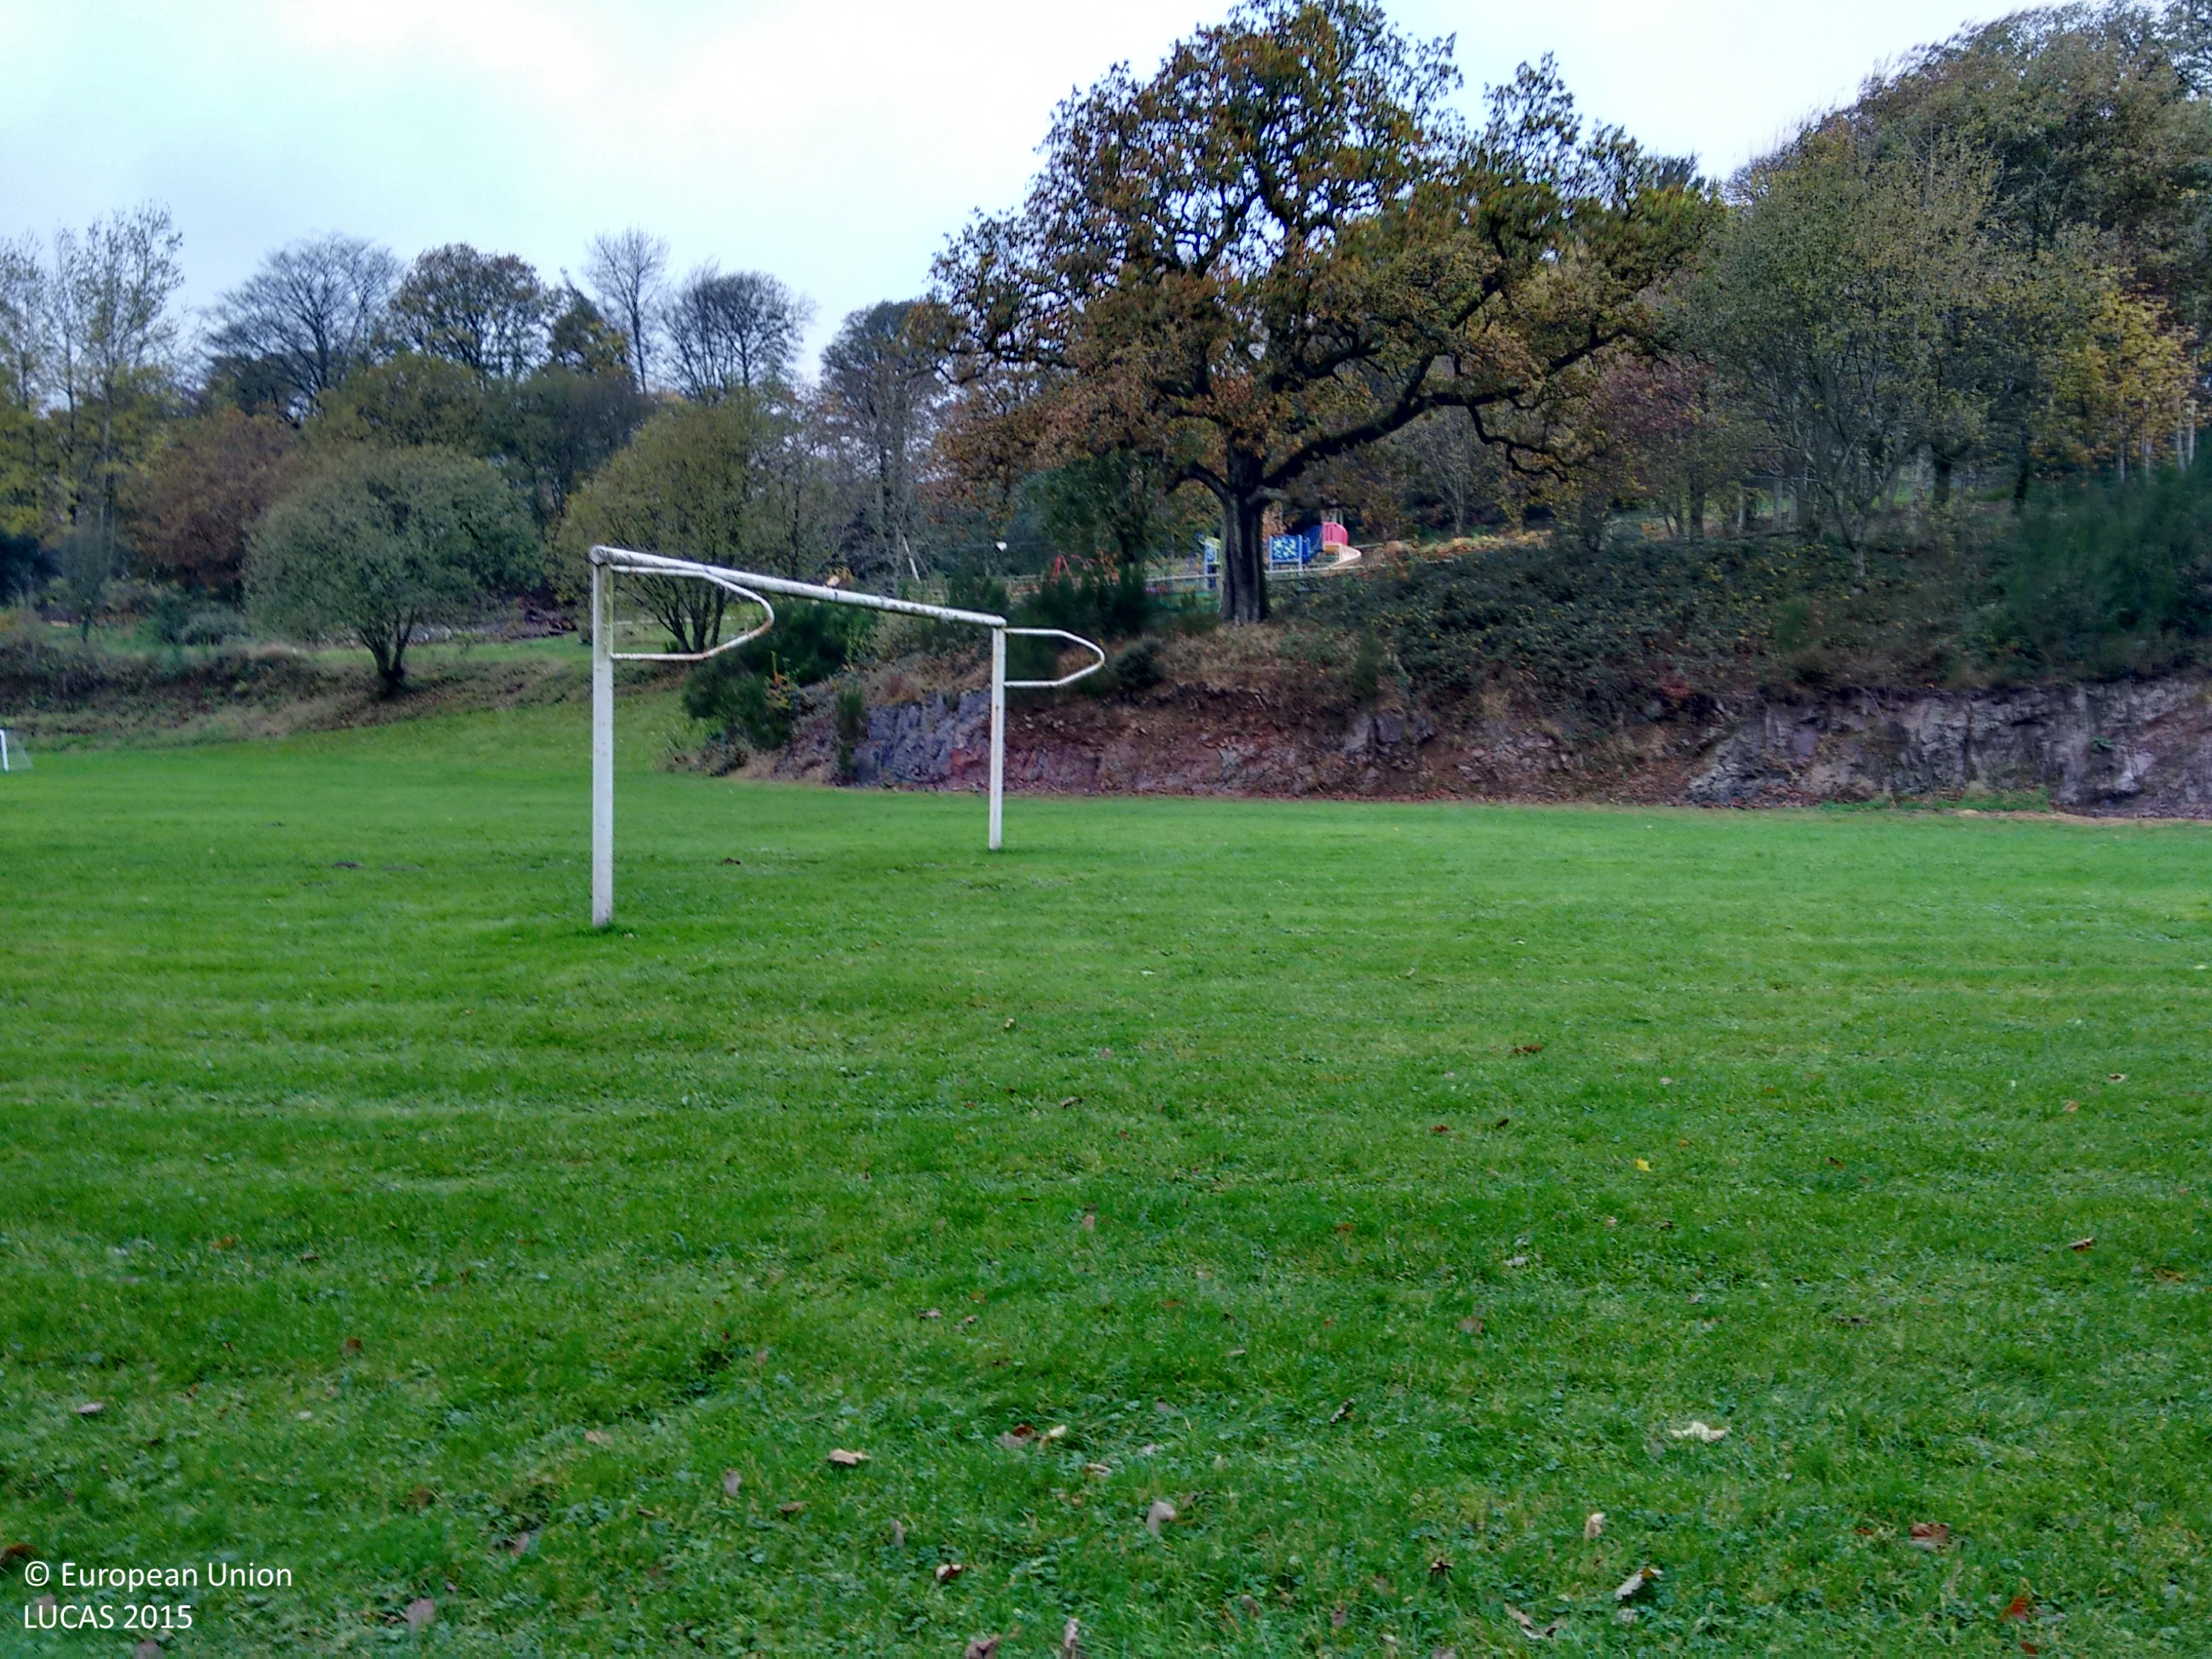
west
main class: Grassland
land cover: Grassland without tree/shrub cover
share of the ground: > 75 %
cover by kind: herbaceous plants 100 %
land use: Sport
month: November
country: GB
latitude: 54.2788
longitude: -3.2083
